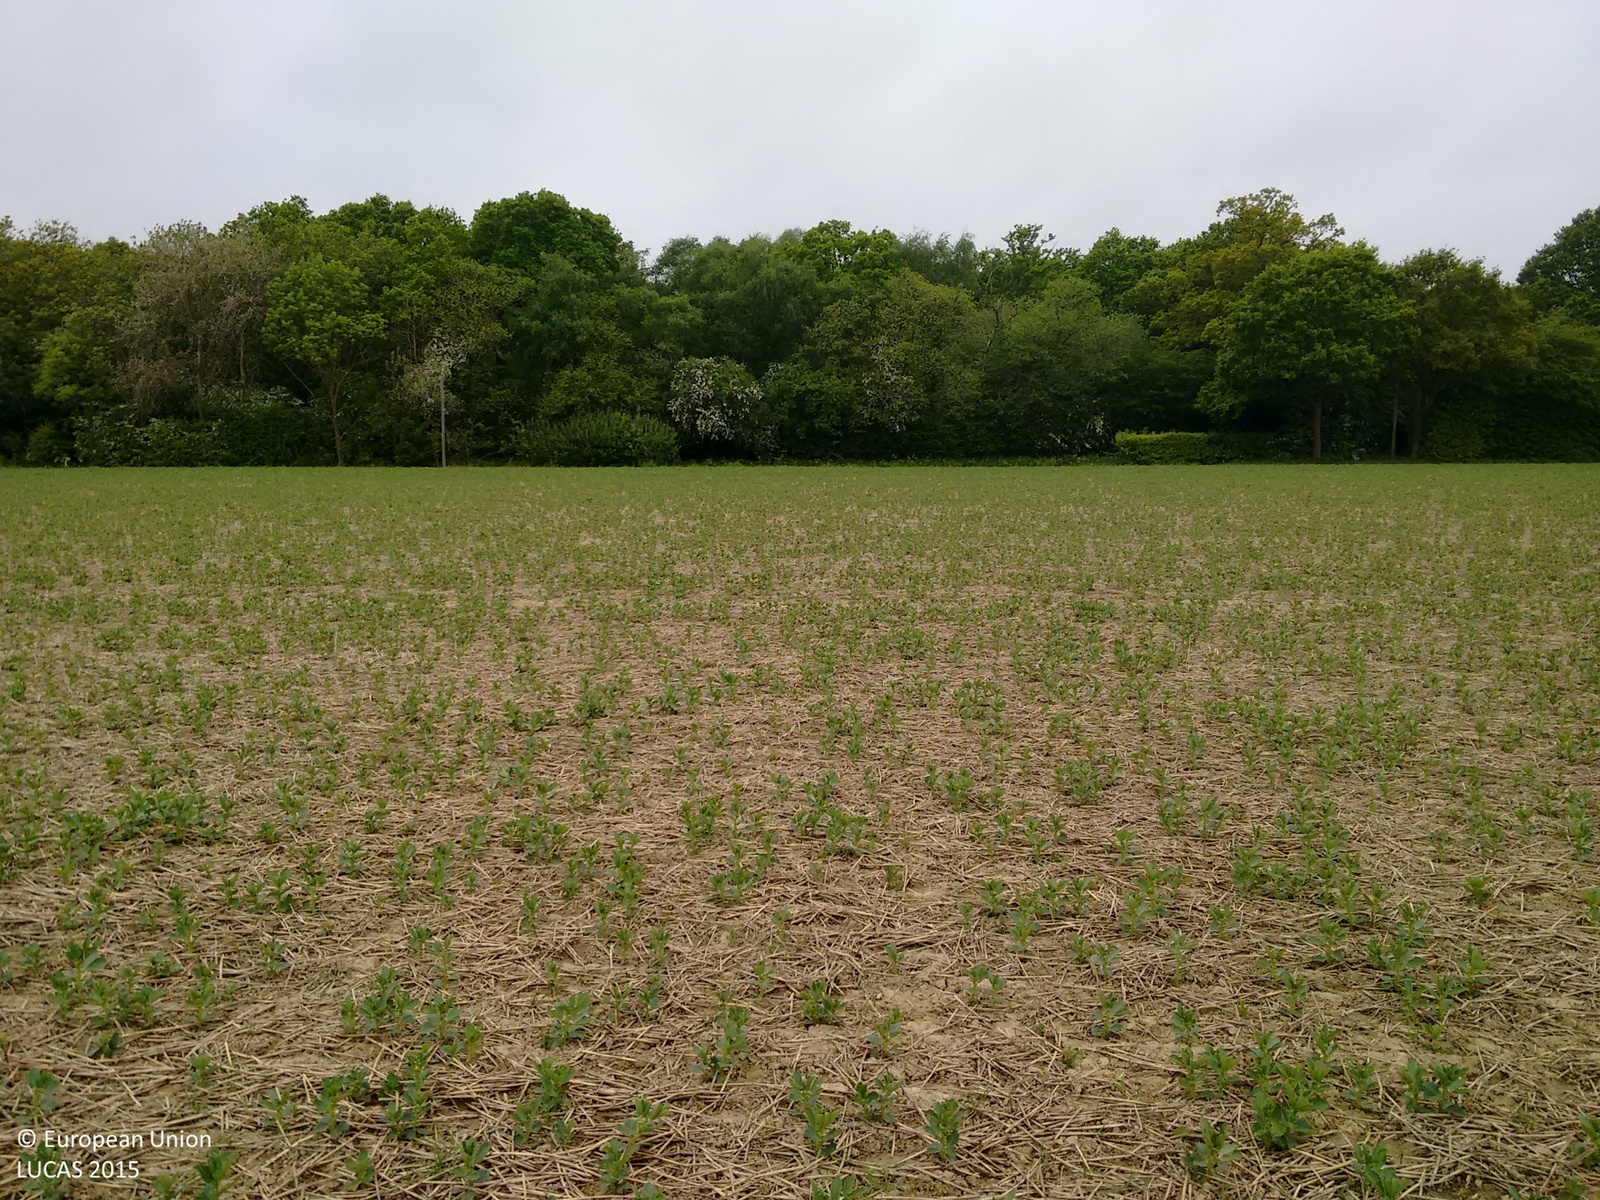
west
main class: Cropland
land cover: Dry pulses
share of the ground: 10 - 25 %
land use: Agriculture (excluding fallow land and kitchen gardens)
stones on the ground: < 10 %
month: May
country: GB
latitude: 51.1467
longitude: 0.5234
